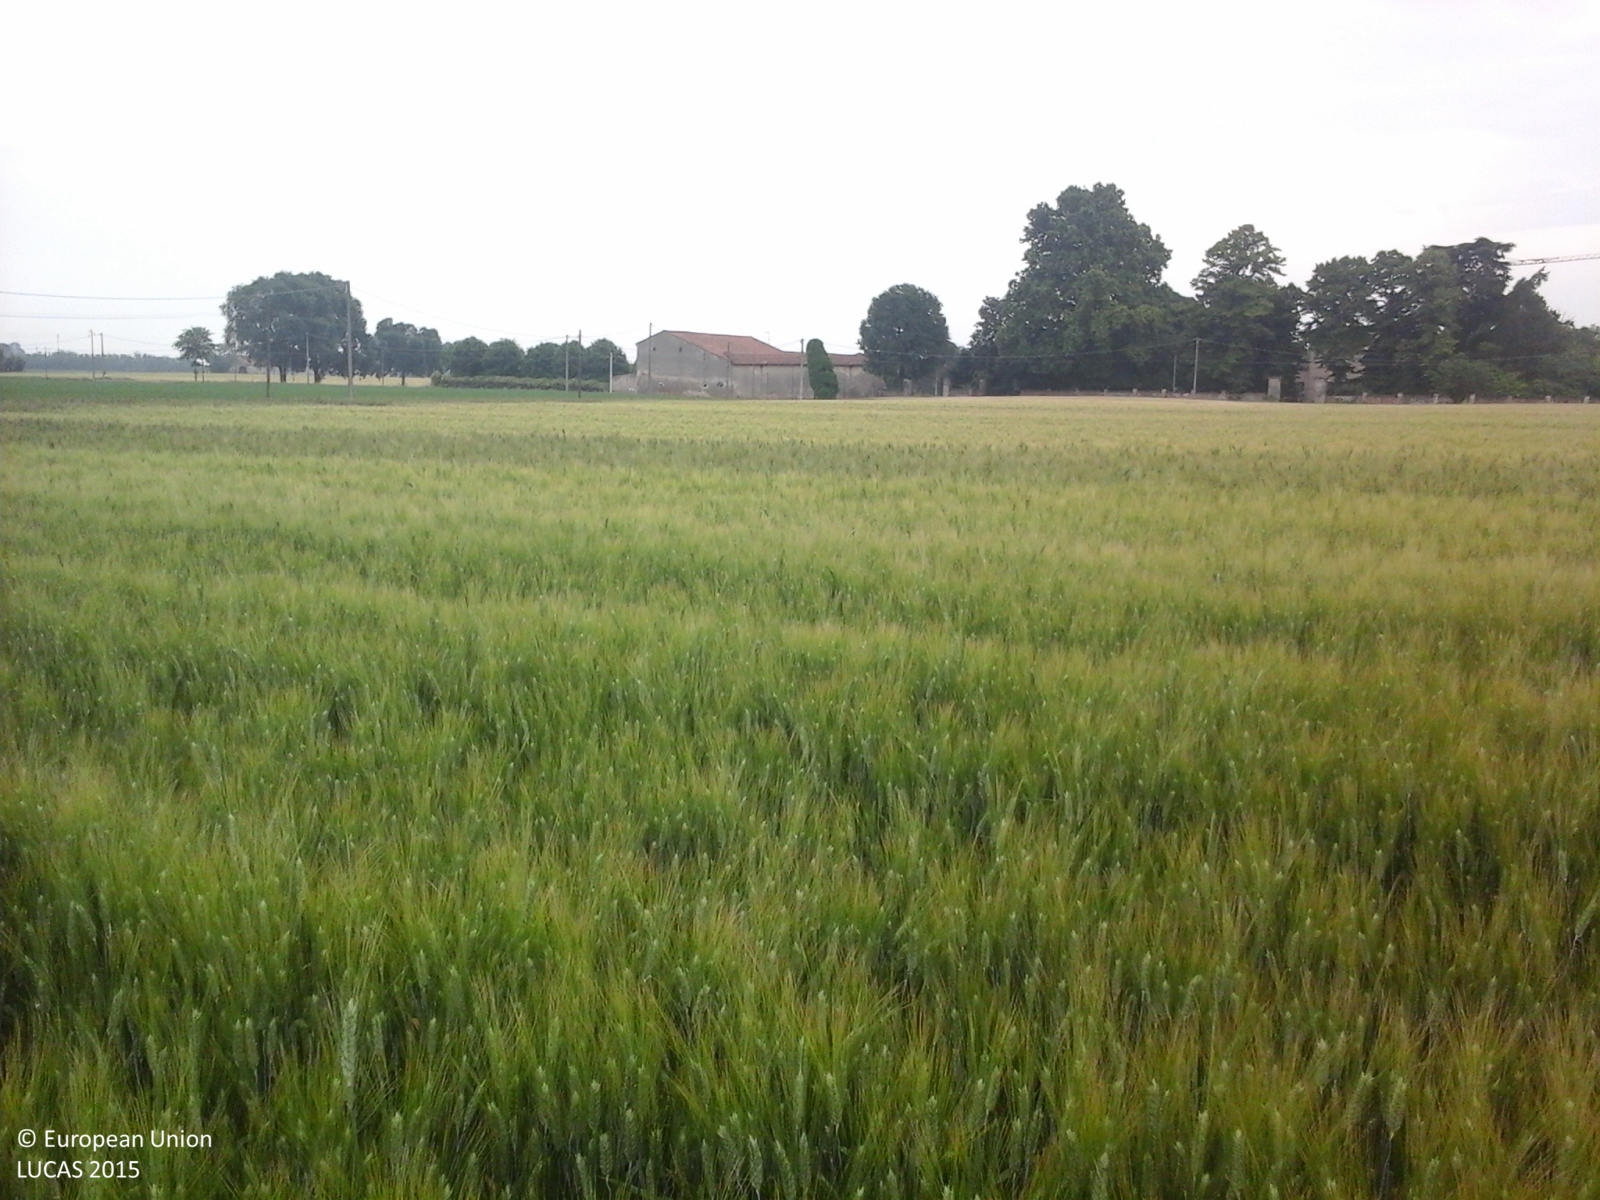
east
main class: Cropland
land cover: Common wheat
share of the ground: > 75 %
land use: Agriculture (excluding fallow land and kitchen gardens)
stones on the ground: < 10 %
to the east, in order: Common wheat; Grass margins; Ditches and canals; Electric lines; Paved roads, cycling and walking lanes; Ditches and canals; Electric lines; Maize; Other bare soil; Ditches and canals; Artificial constructions in urban areas
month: May
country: IT
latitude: 45.1416
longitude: 10.6981
